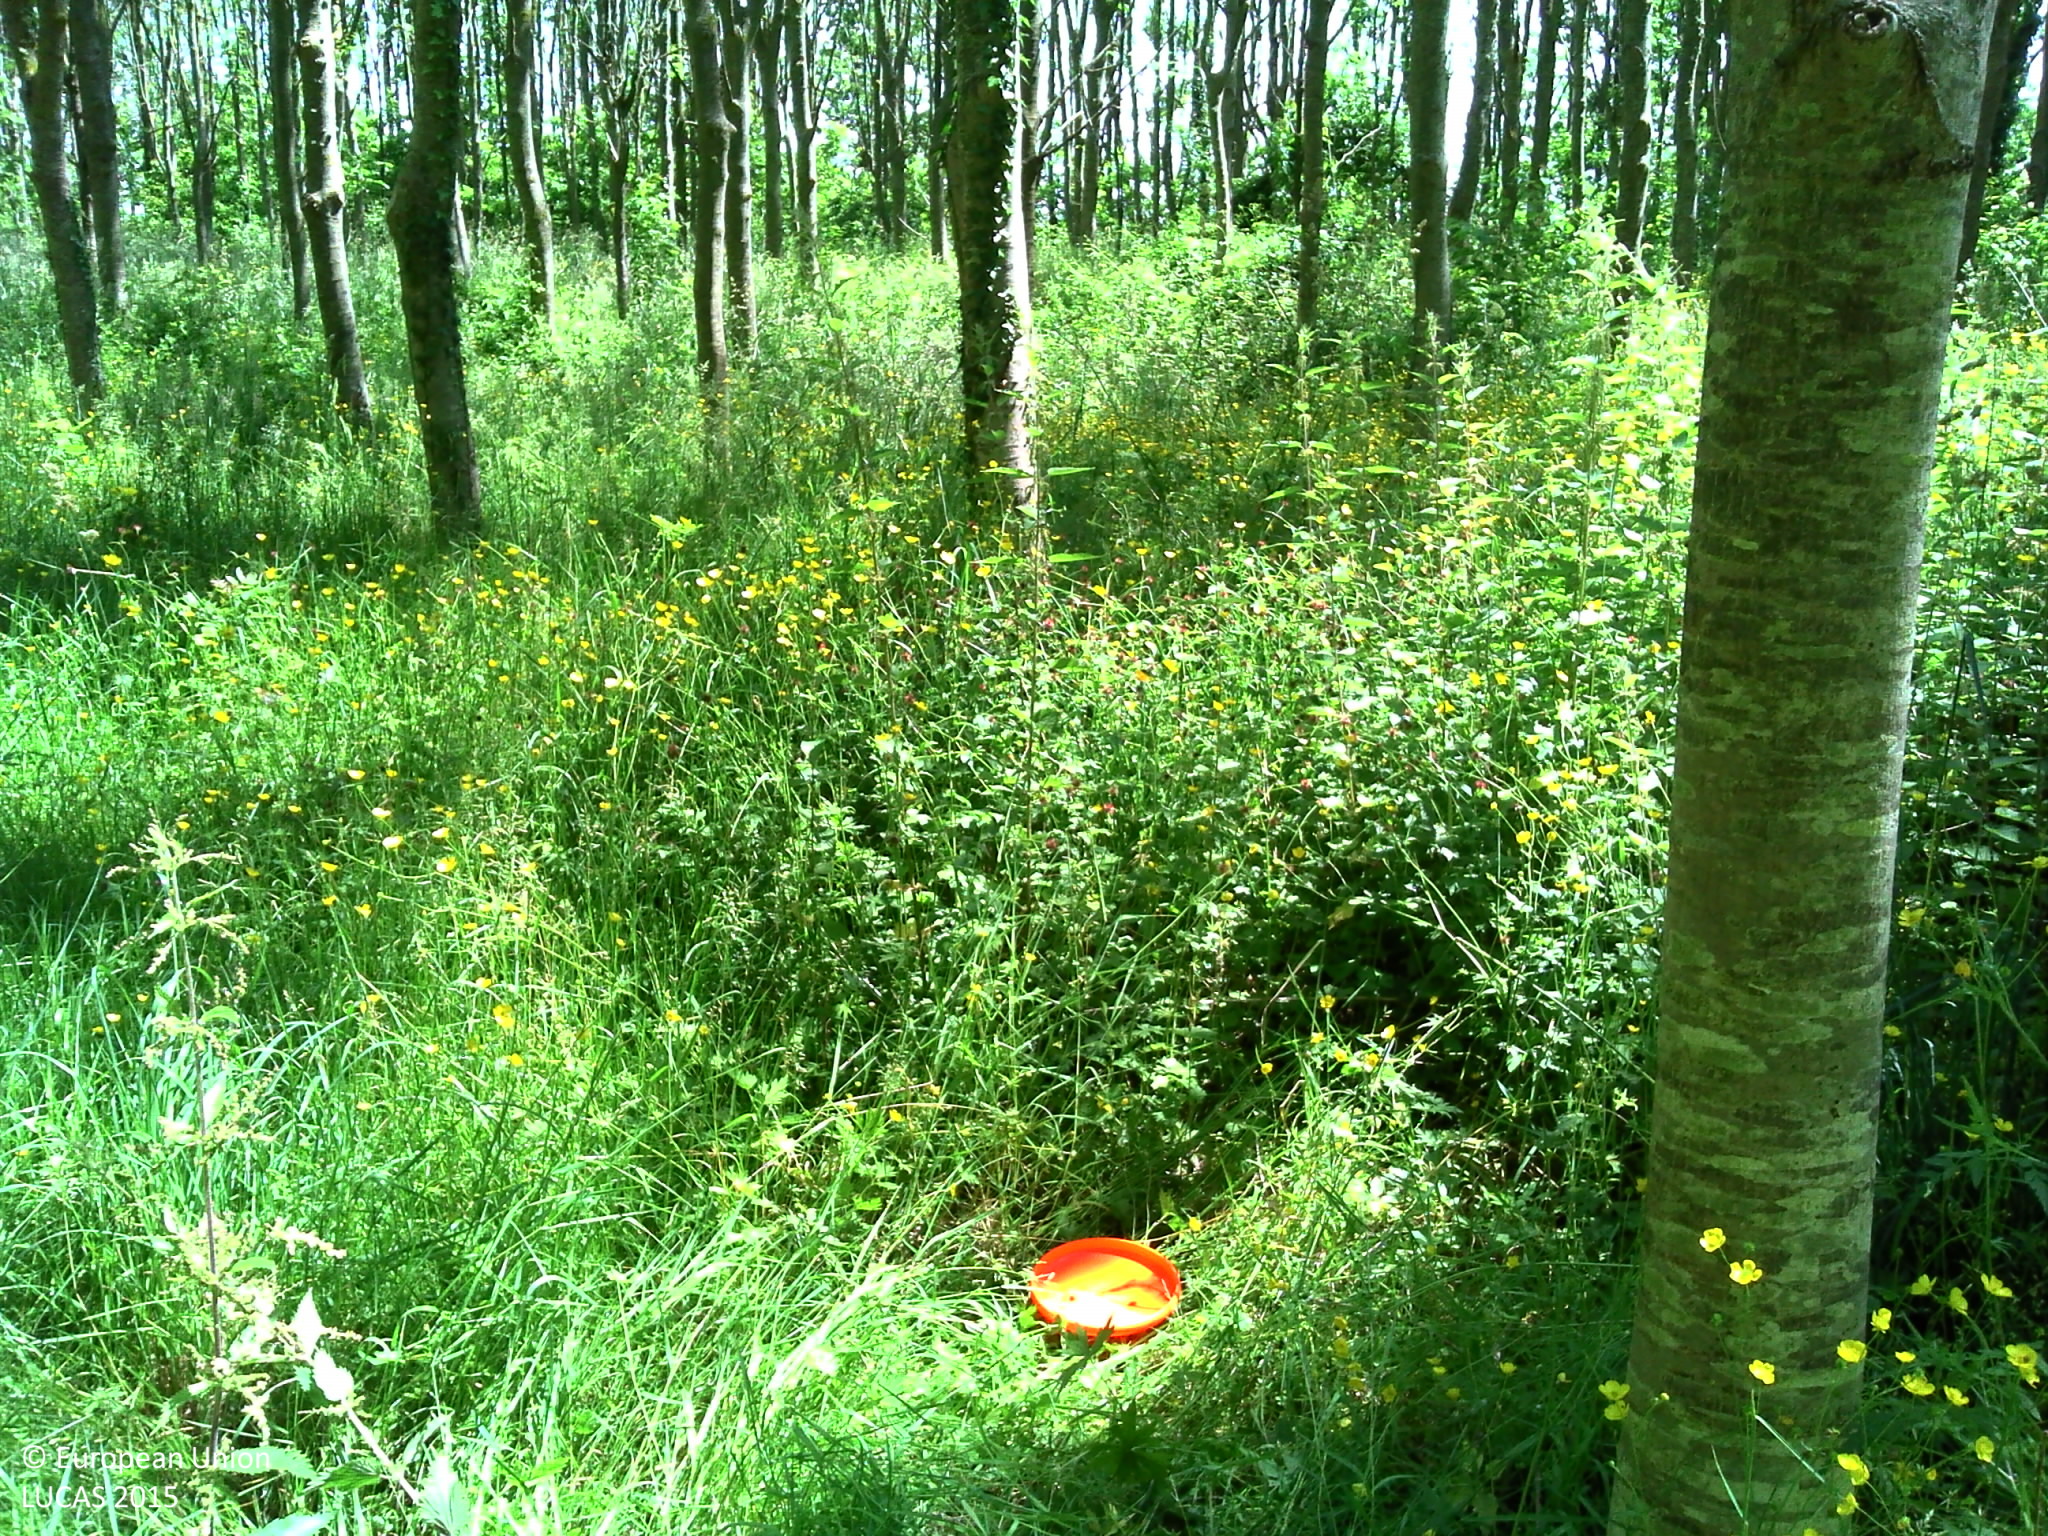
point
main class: Woodland
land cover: Broadleaved woodland
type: mesophytic deciduous forest
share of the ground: 50 - 75 %
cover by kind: broadleaved forest trees 60 %, herbaceous plants 20 %
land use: Forestry
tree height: > 5 m
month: June
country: FR
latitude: 50.7762
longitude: 2.0857
